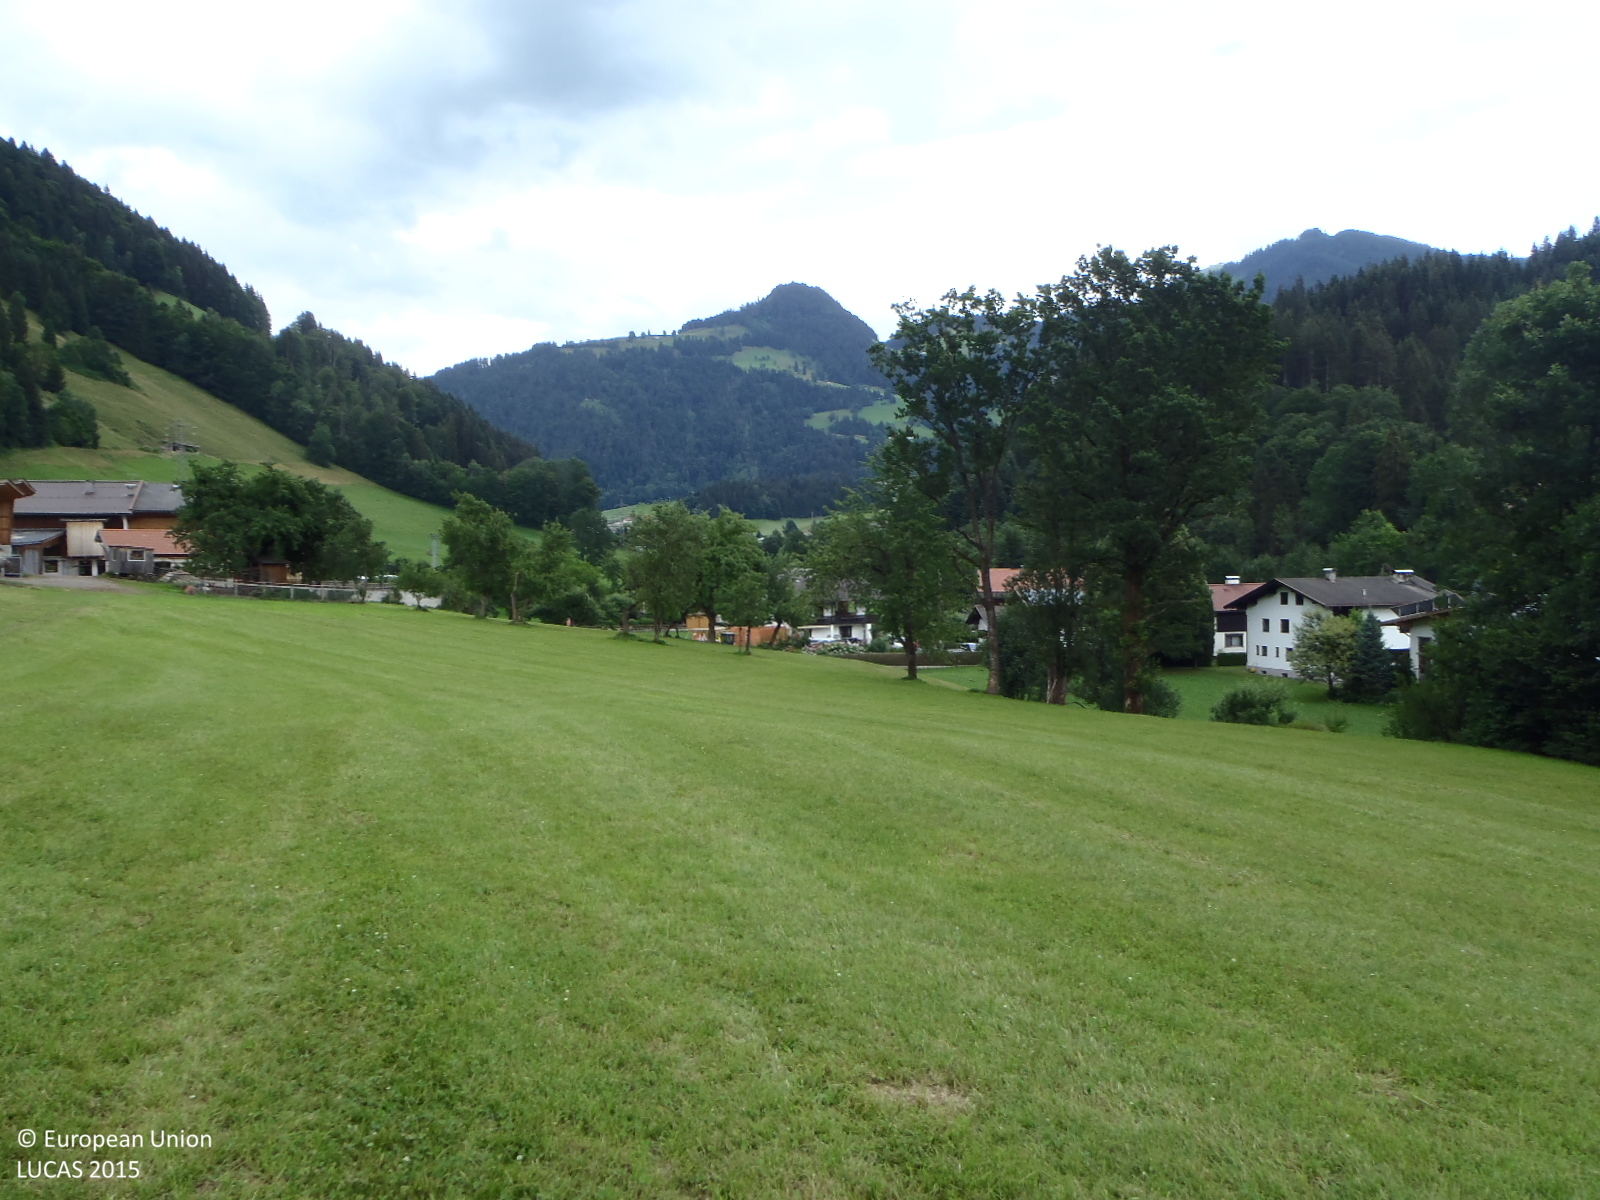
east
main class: Grassland
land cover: Grassland without tree/shrub cover
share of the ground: > 75 %
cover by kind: herbaceous plants 100 %
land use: Agriculture (excluding fallow land and kitchen gardens)
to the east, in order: Grassland without tree/shrub cover; Other fruit trees and berries; Grassland without tree/shrub cover; Pear fruit; Grassland without tree/shrub cover; Artificial constructions in urban areas; Grassland without tree/shrub cover; Single bushes/trees; Artificial constructions in urban areas; Grassland without tree/shrub cover
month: July
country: AT
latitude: 47.4827
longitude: 12.1350
